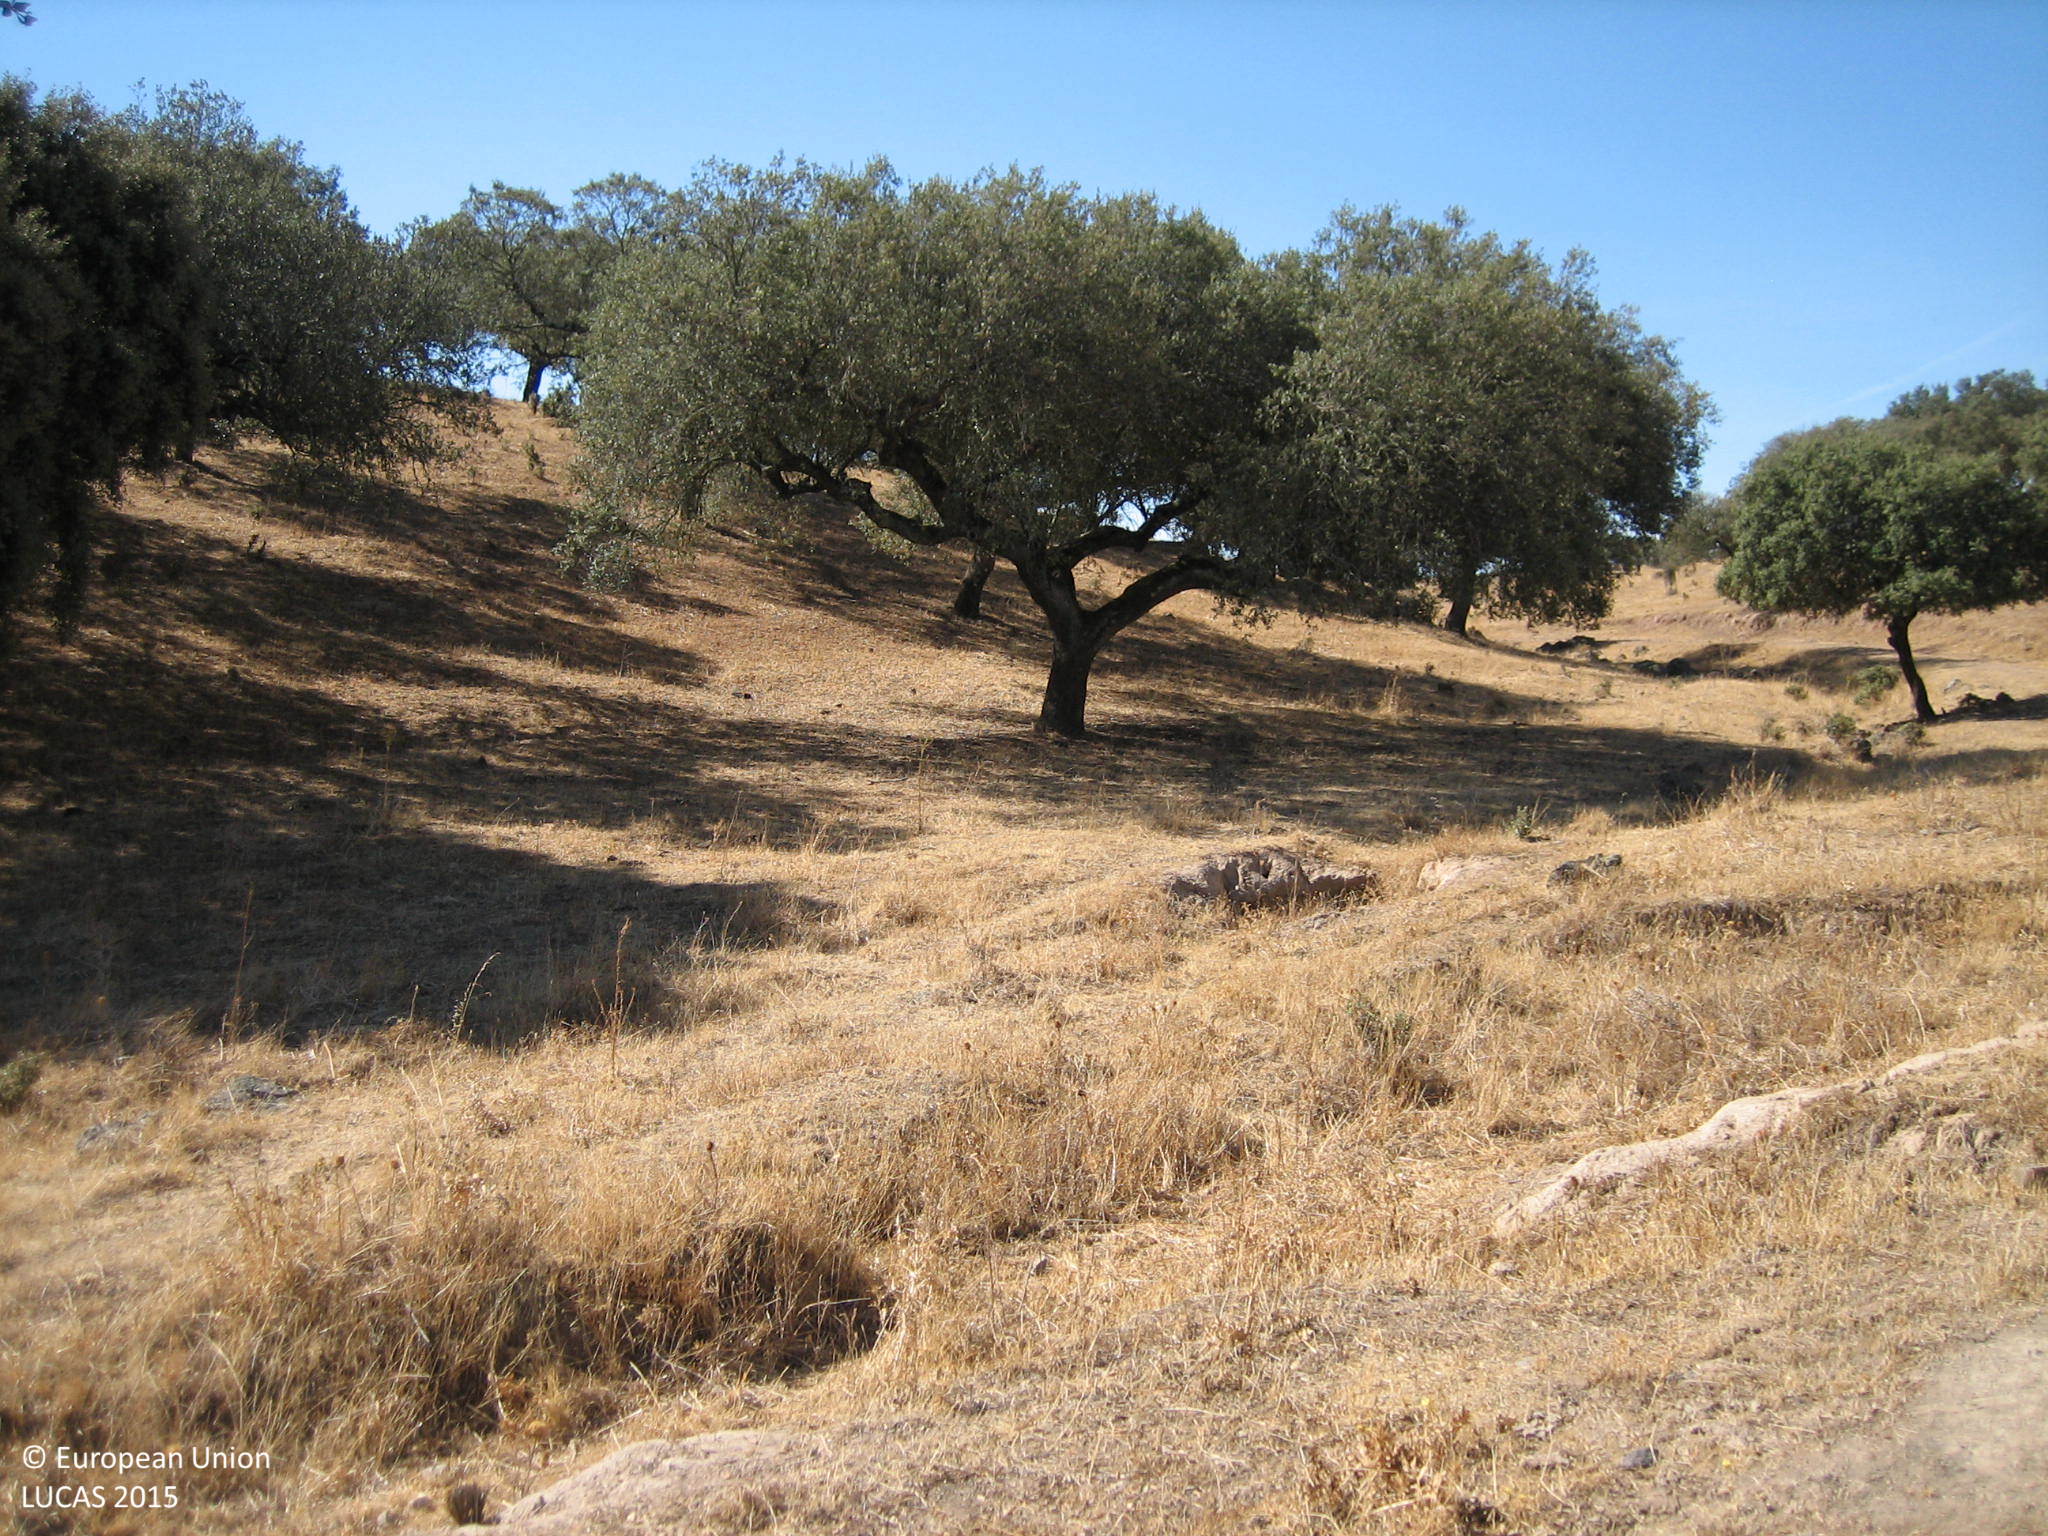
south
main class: Grassland
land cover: Grassland with sparse tree/shrub cover
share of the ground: > 75 %
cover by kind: herbaceous plants 95 %, broadleaved forest trees 5 %
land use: Forestry
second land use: Agriculture (excluding fallow land and kitchen gardens)
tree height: < 5 m
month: August
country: ES
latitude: 38.5332
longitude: -7.1954
